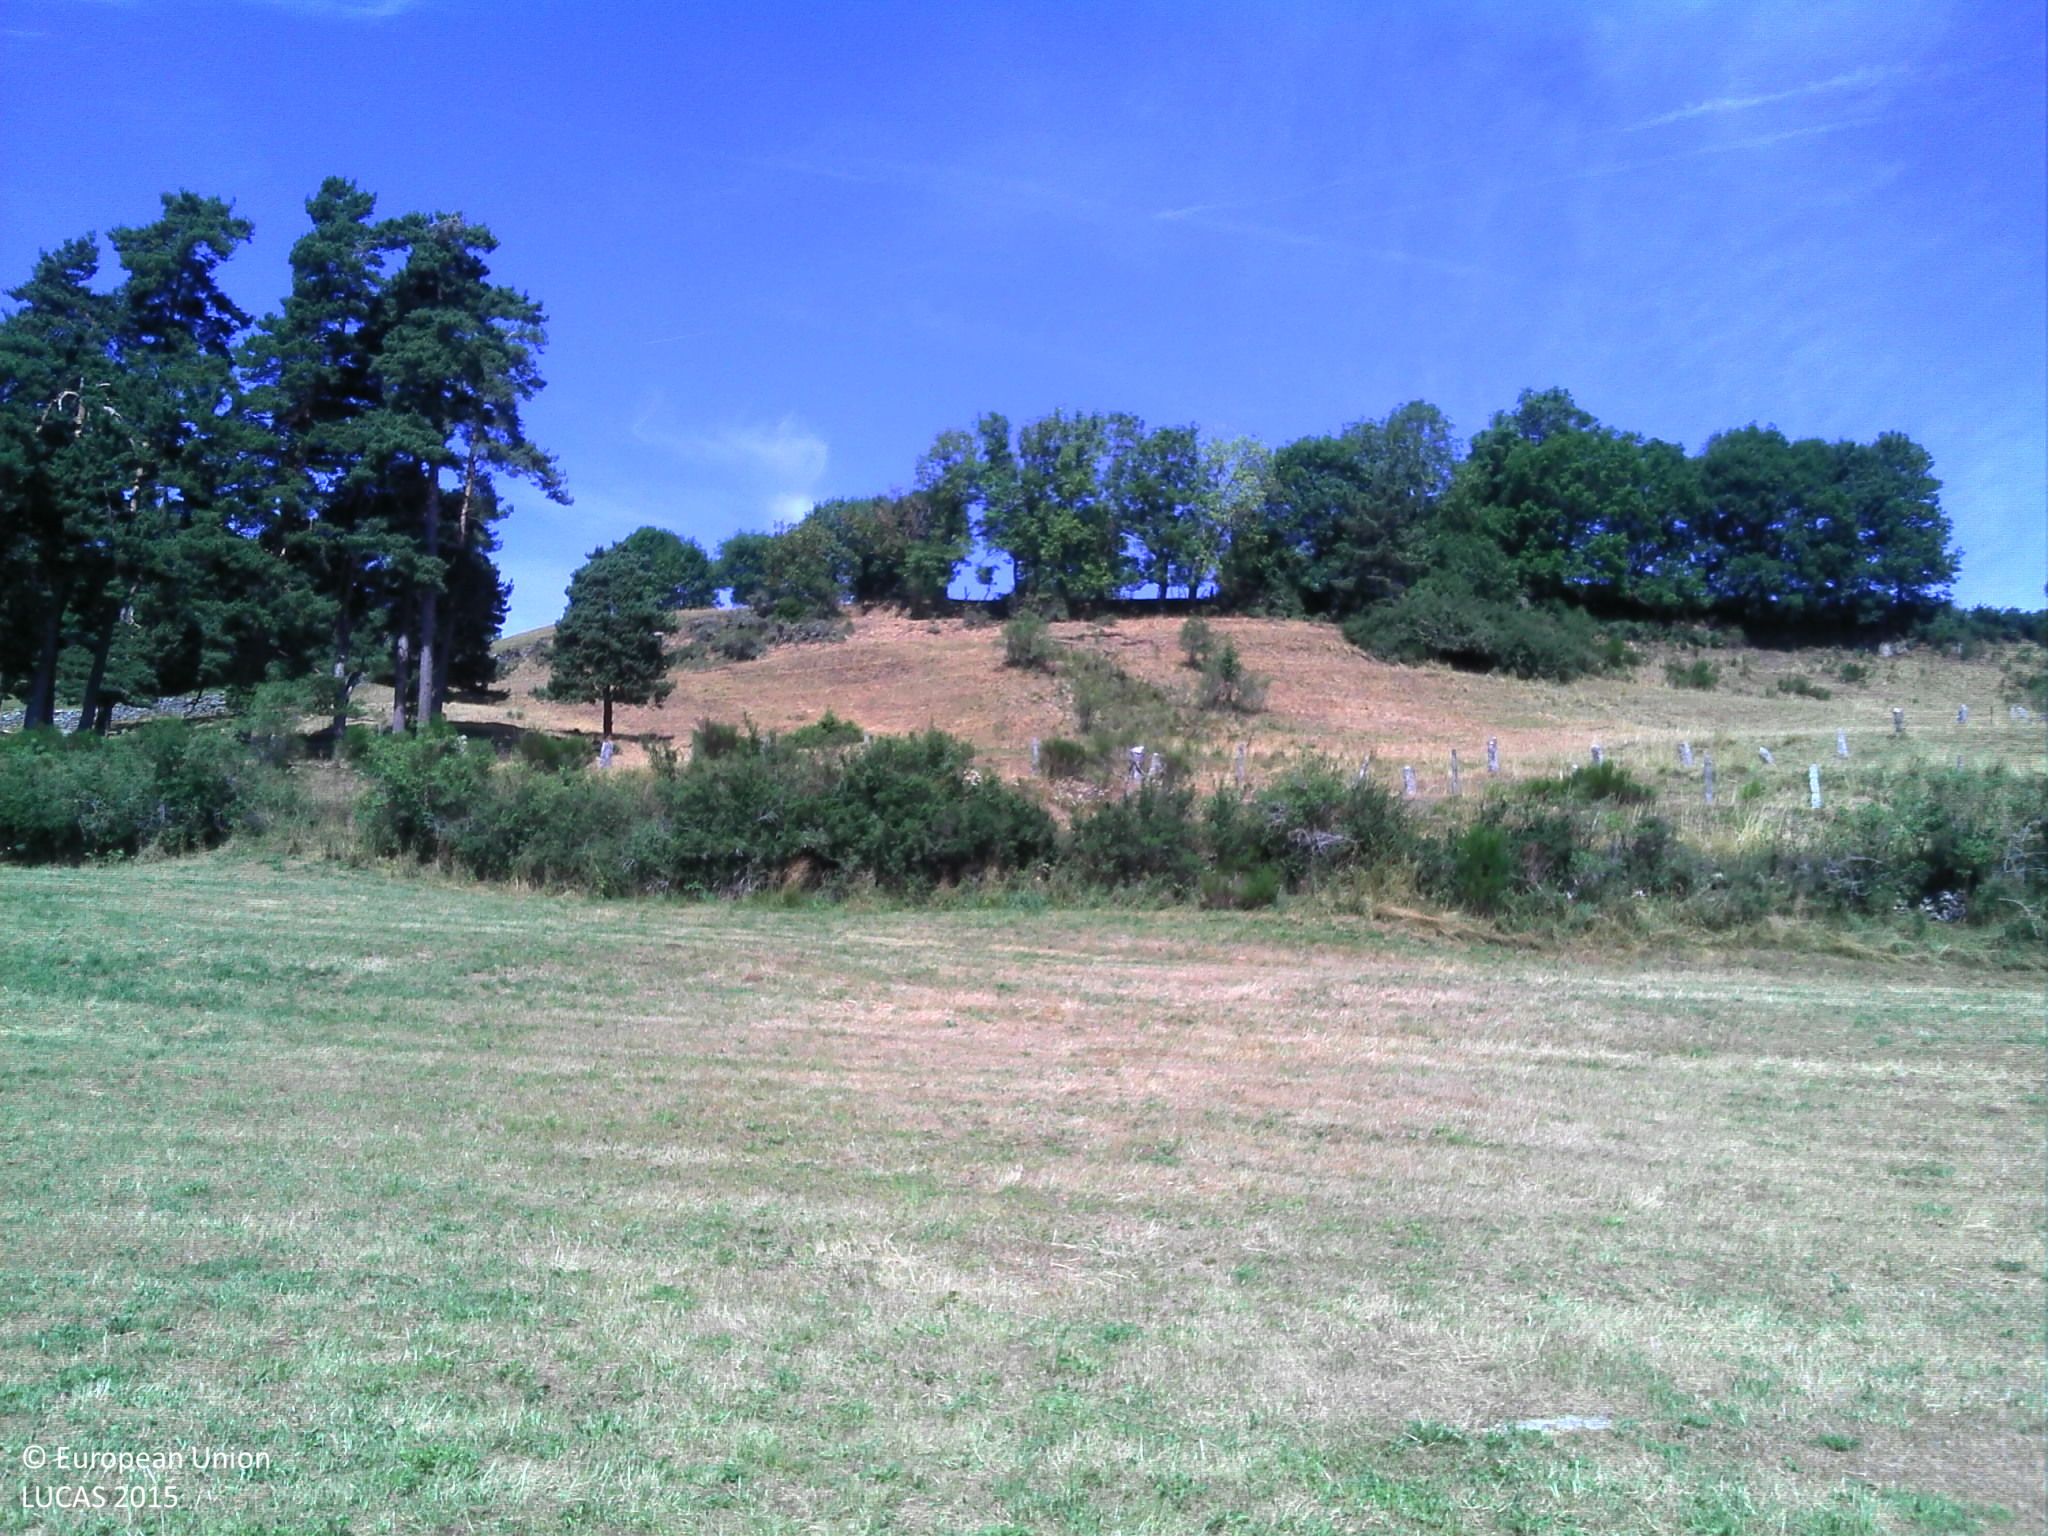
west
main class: Grassland
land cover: Grassland without tree/shrub cover
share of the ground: > 75 %
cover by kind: herbaceous plants 100 %
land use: Agriculture (excluding fallow land and kitchen gardens)
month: July
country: FR
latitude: 44.7260
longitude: 3.2237
